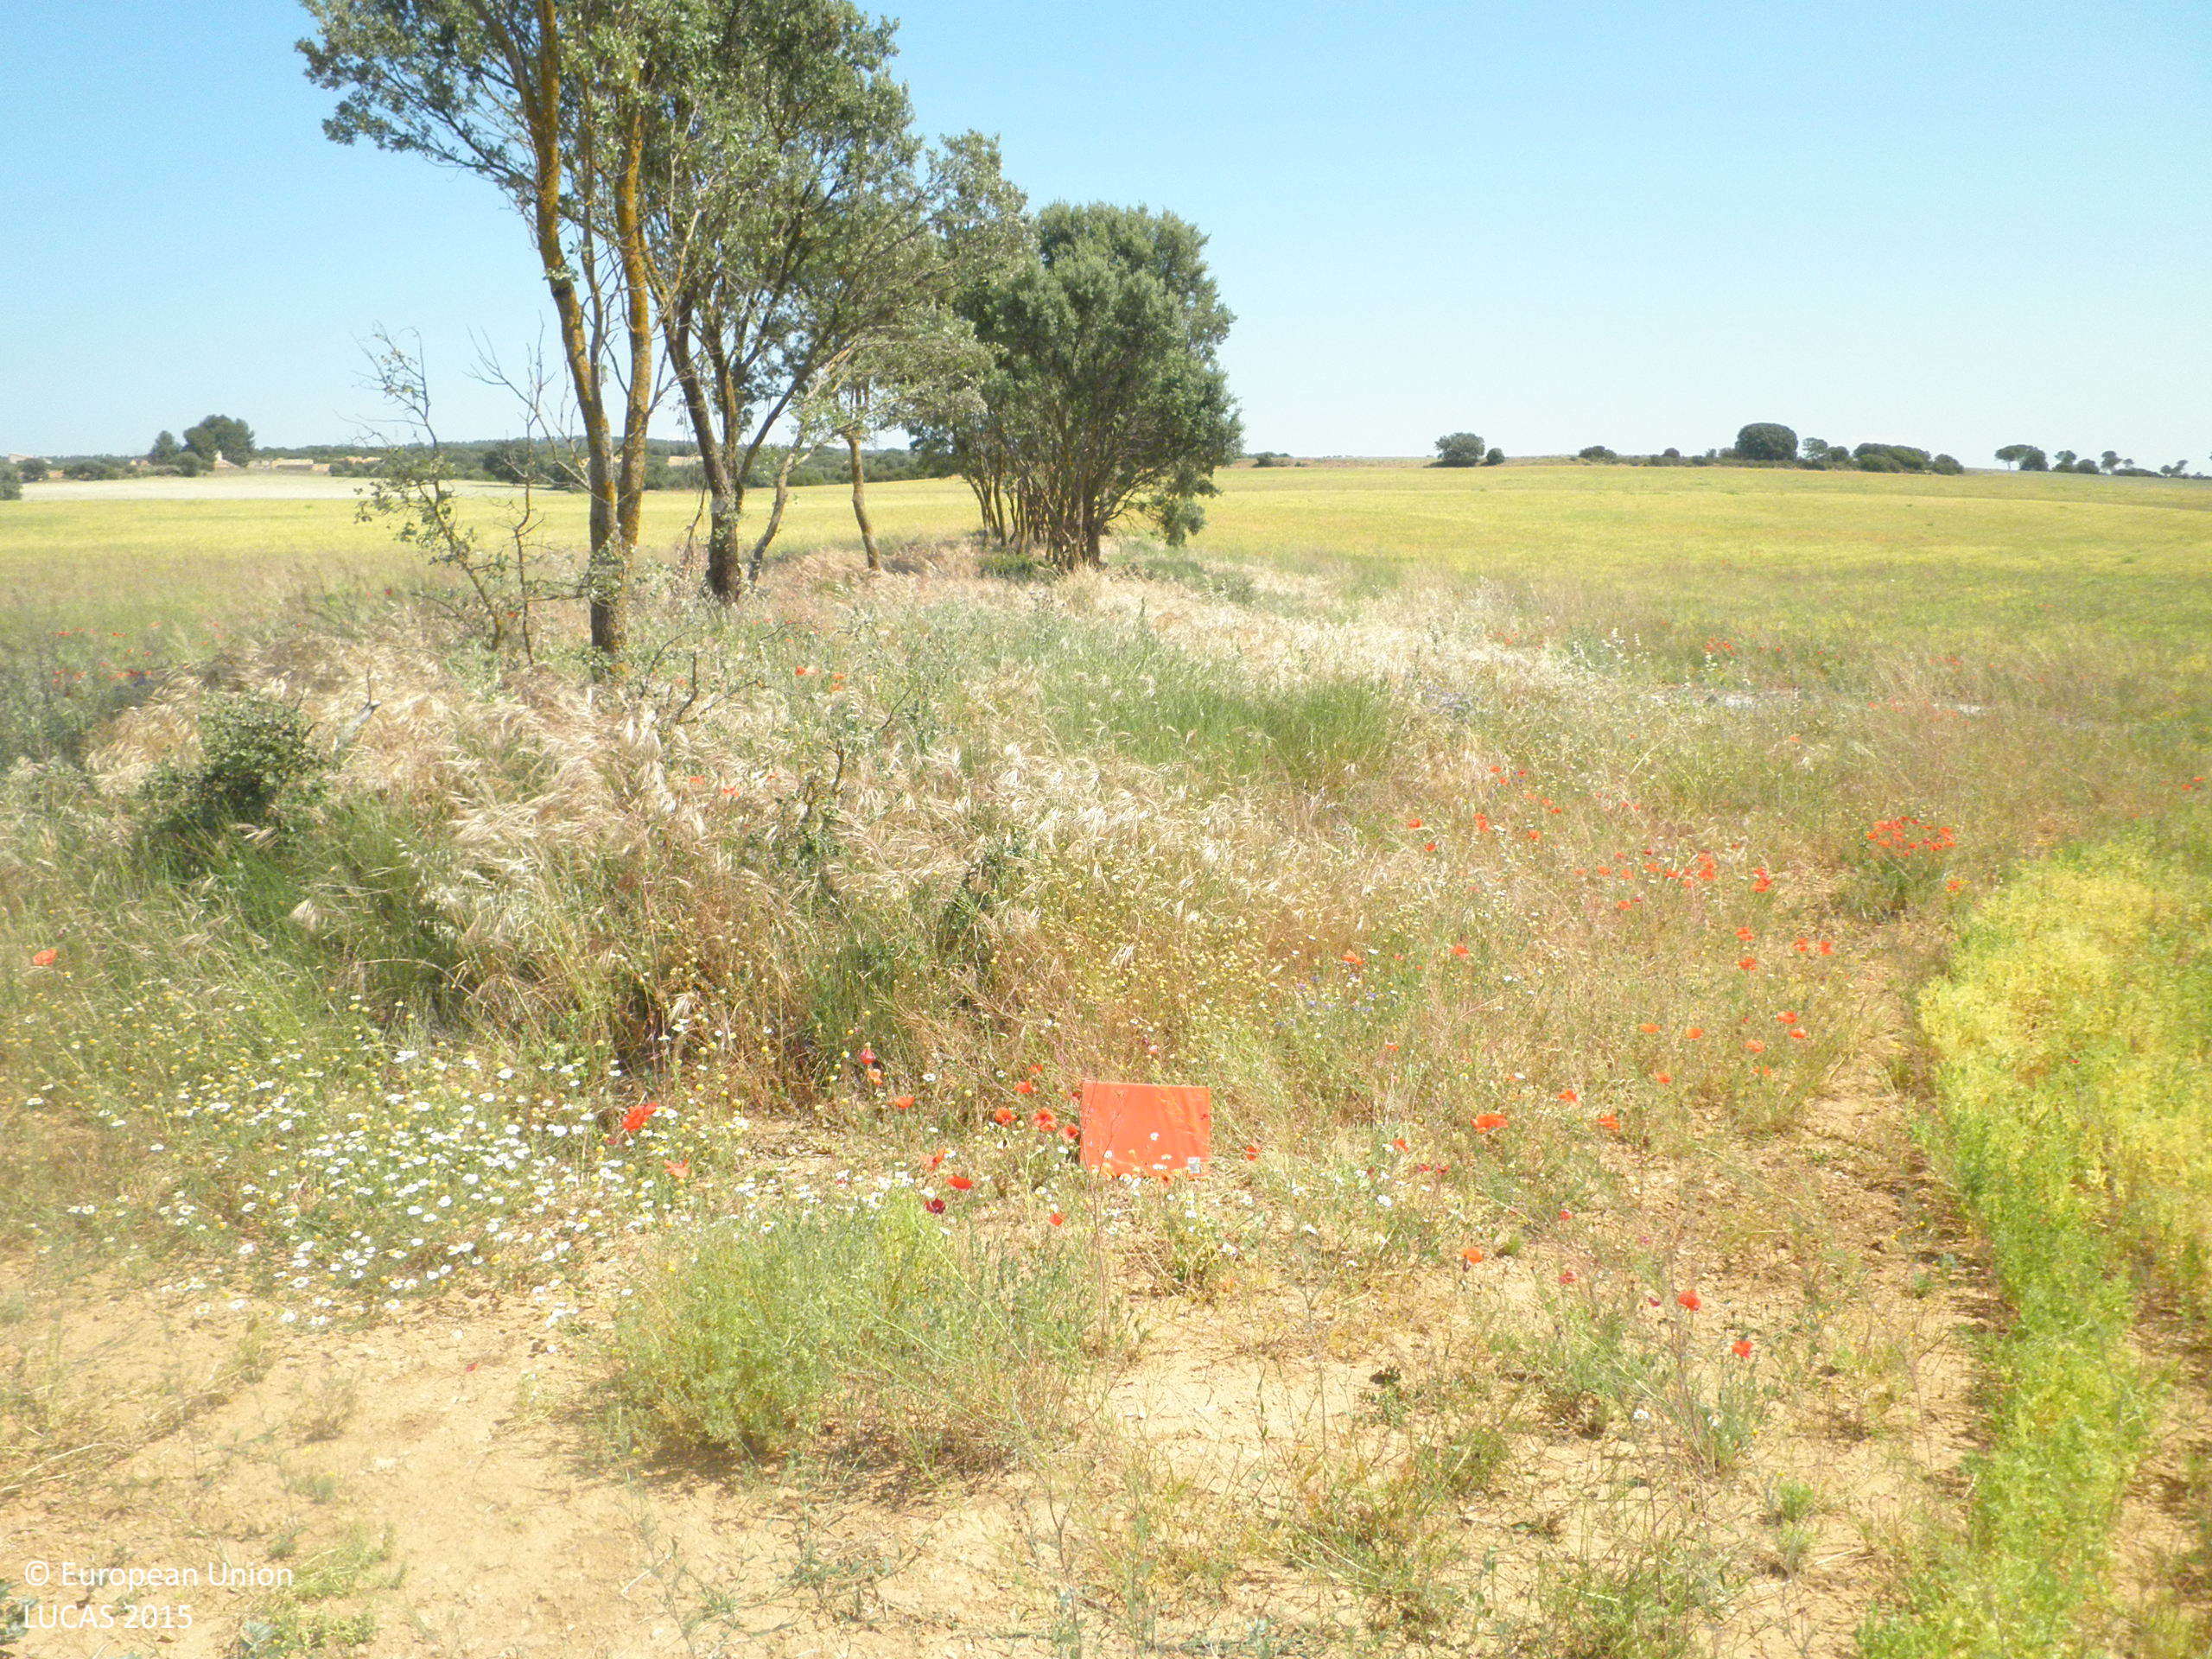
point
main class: Woodland
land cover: Broadleaved woodland
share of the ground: > 75 %
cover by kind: herbaceous plants 60 %, unconsolidated bare surface 25 %, broadleaved forest trees 15 %
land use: Semi-natural and natural areas not in use
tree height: < 5 m
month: June
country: ES
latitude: 39.5145
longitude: -1.8123
